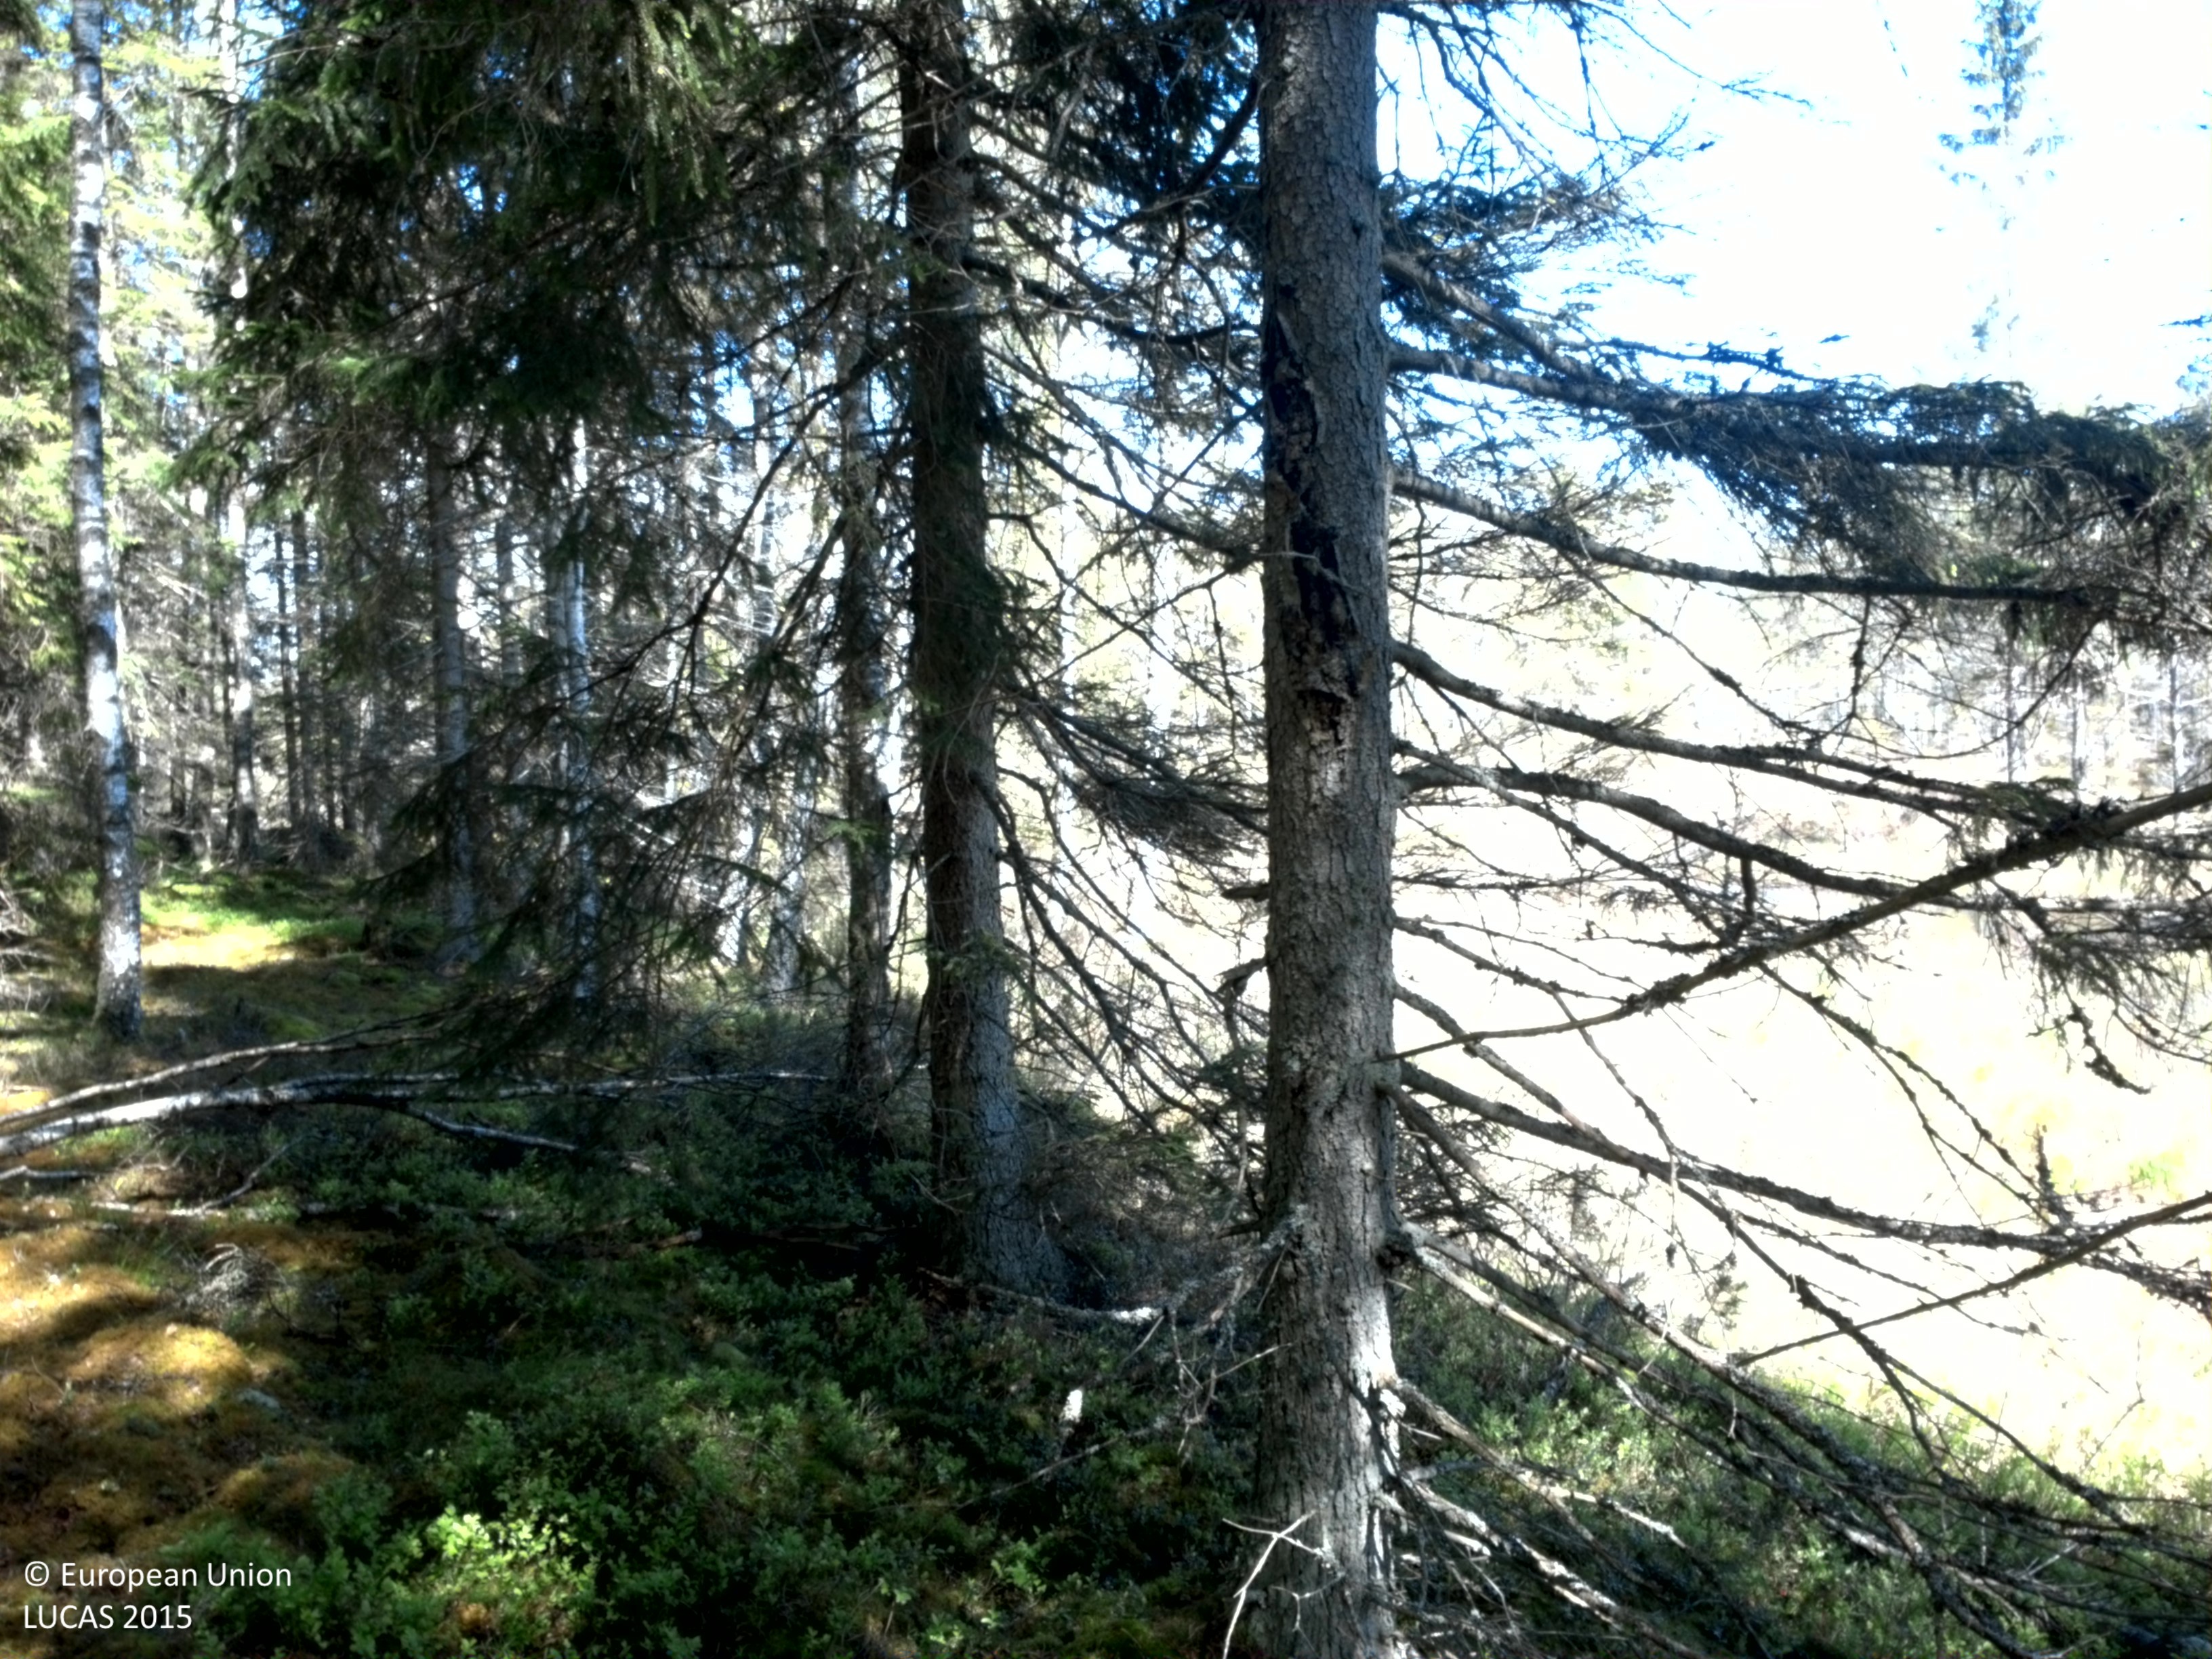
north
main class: Woodland
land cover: Spruce dominated coniferous woodland
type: boreal forest
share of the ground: 50 - 75 %
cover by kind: coniferous forest trees 45 %, lichens and mosses 30 %, broadleaved forest trees 10 %, shrubs 10 %, herbaceous plants 5 %
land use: Forestry
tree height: > 5 m
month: May
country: SE
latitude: 56.8977
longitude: 15.5310
